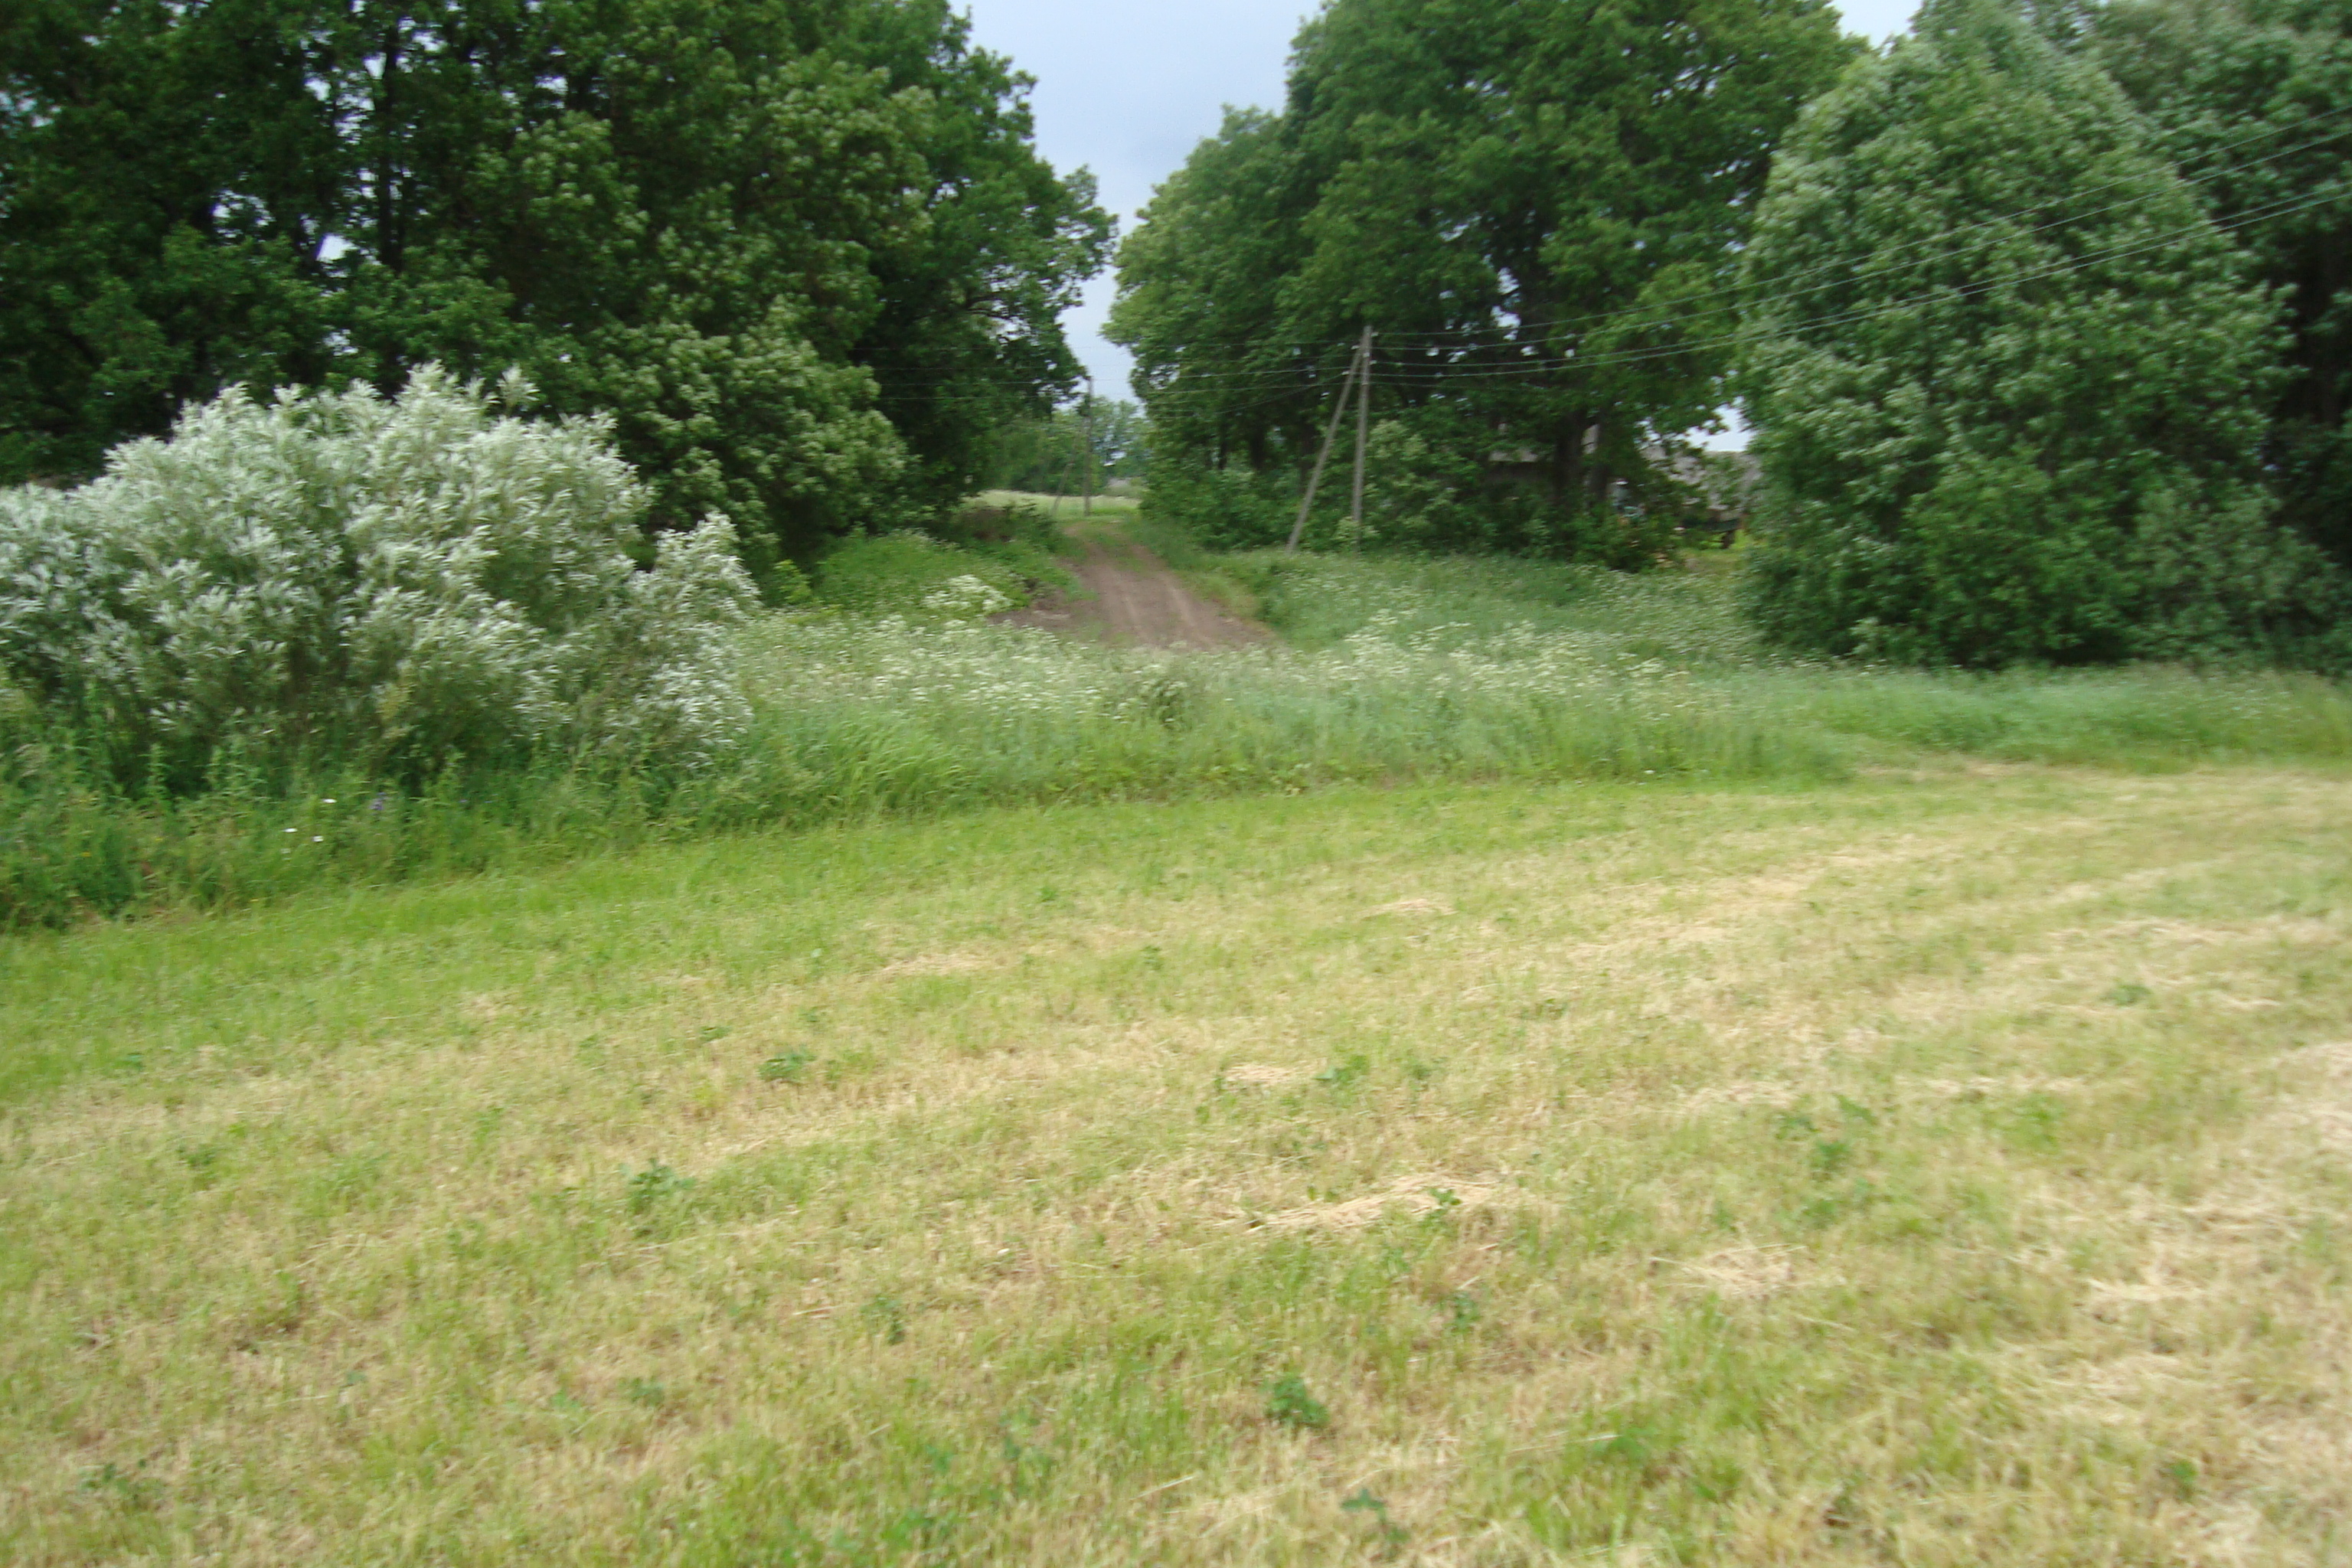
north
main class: Grassland
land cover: Grassland without tree/shrub cover
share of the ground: > 75 %
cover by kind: herbaceous plants 100 %
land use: Agriculture (excluding fallow land and kitchen gardens)
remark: Harvested field
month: June
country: LV
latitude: 57.1823
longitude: 26.4040
